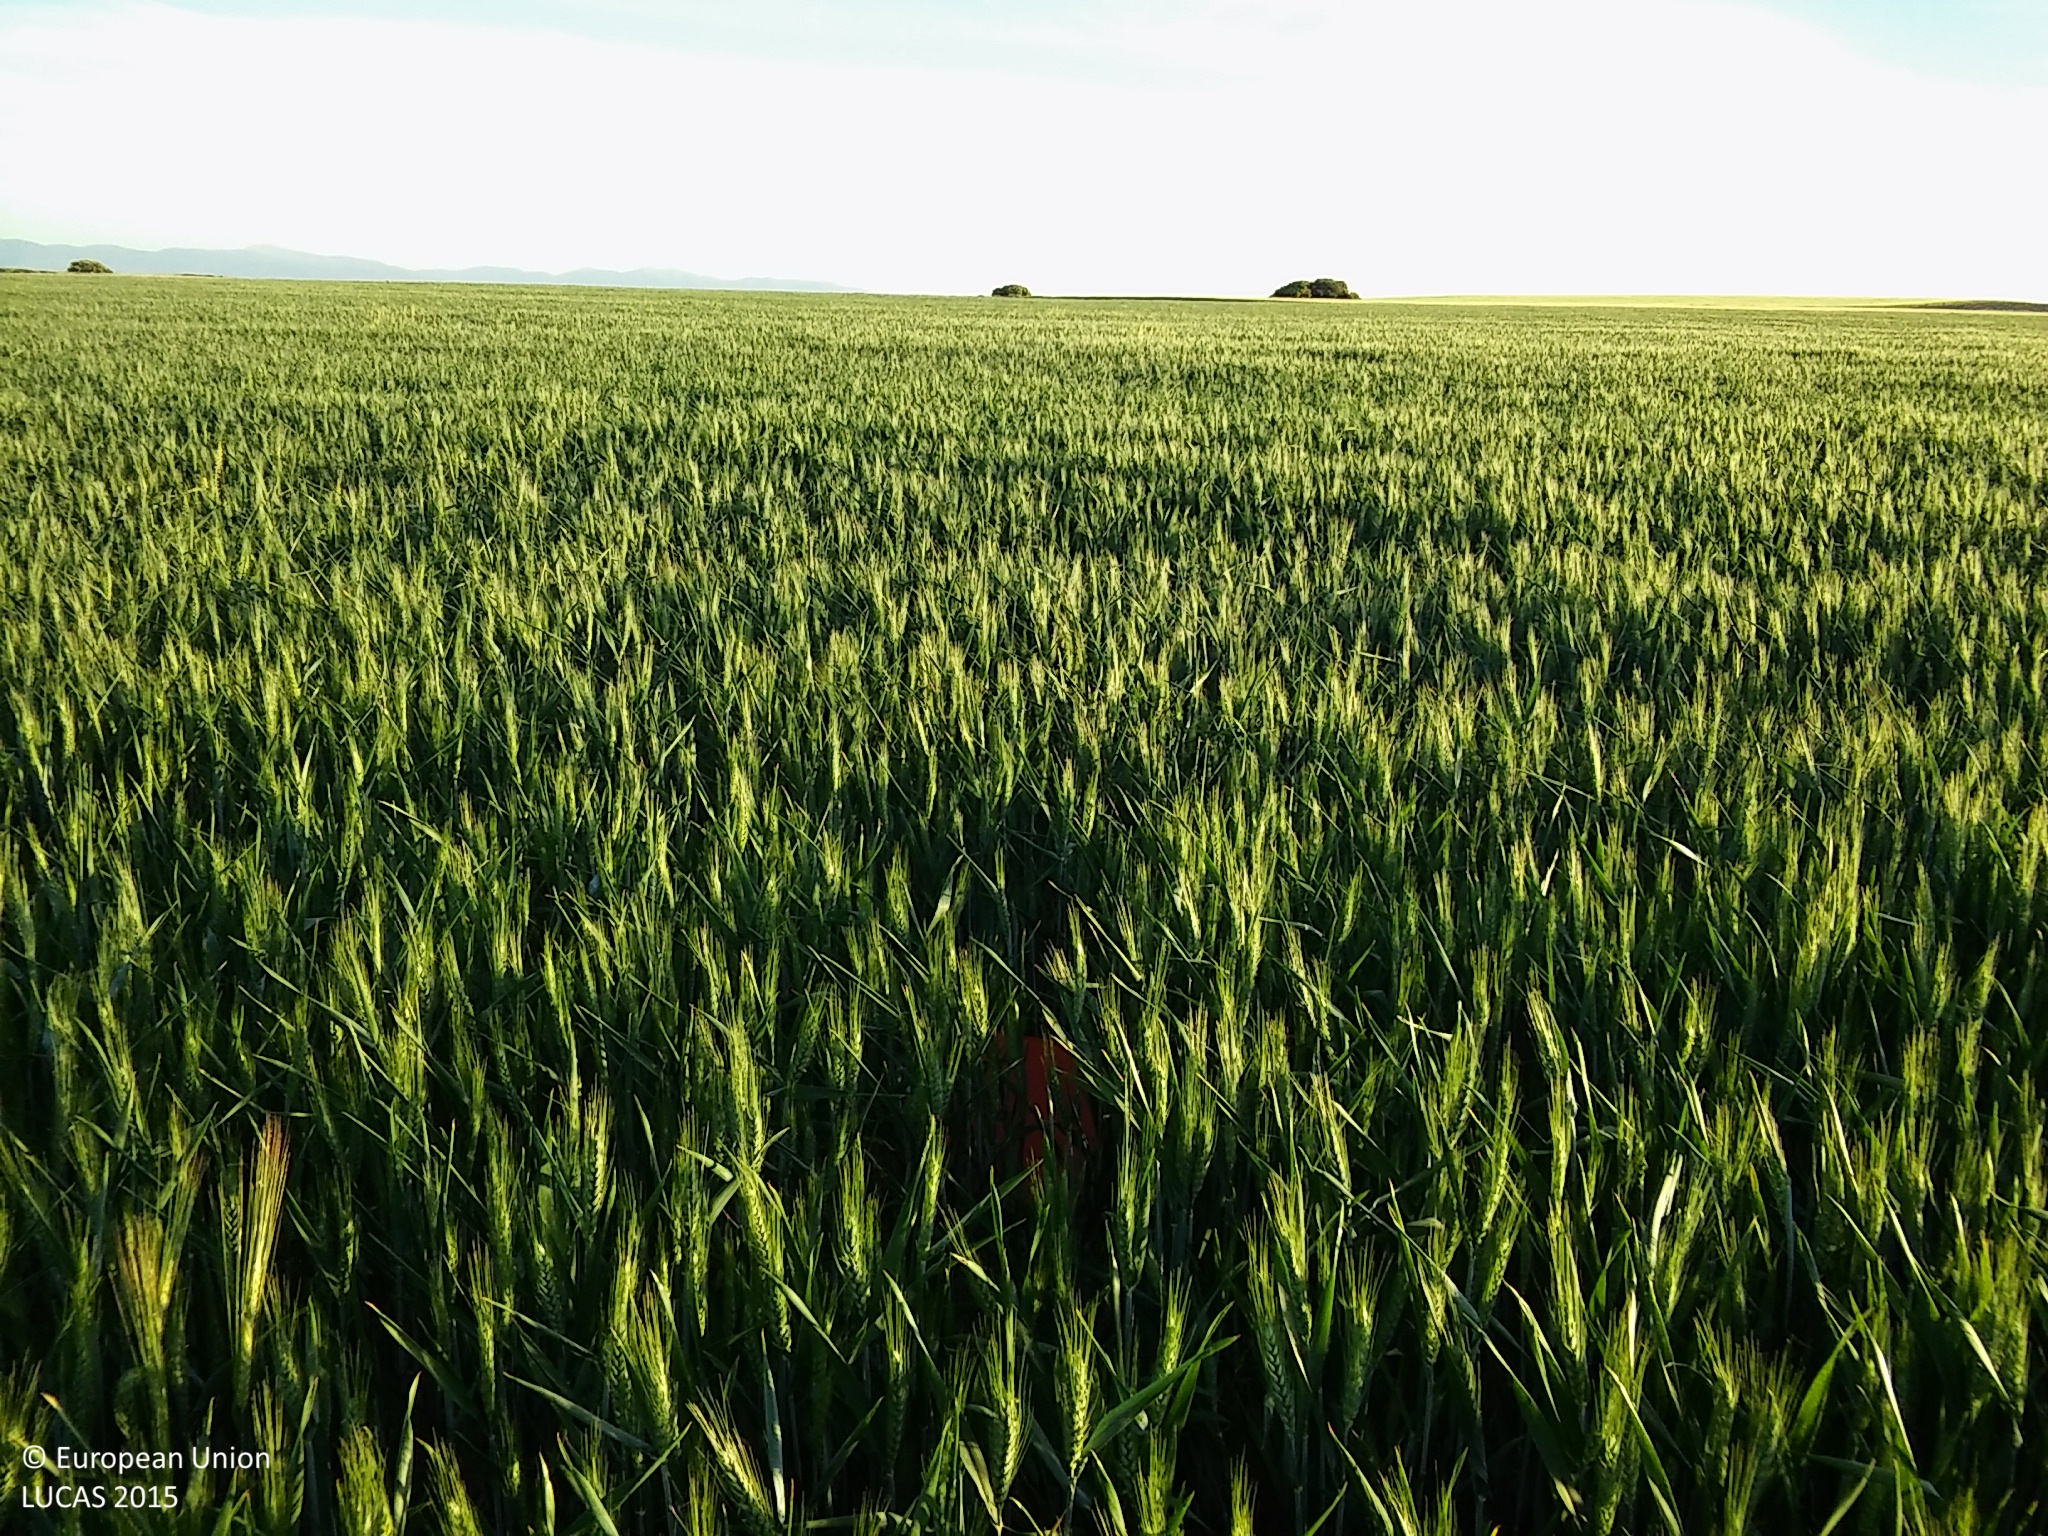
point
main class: Cropland
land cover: Common wheat
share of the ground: > 75 %
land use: Agriculture (excluding fallow land and kitchen gardens)
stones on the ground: 25 - 50 %
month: May
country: ES
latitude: 41.3998
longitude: -4.0129
